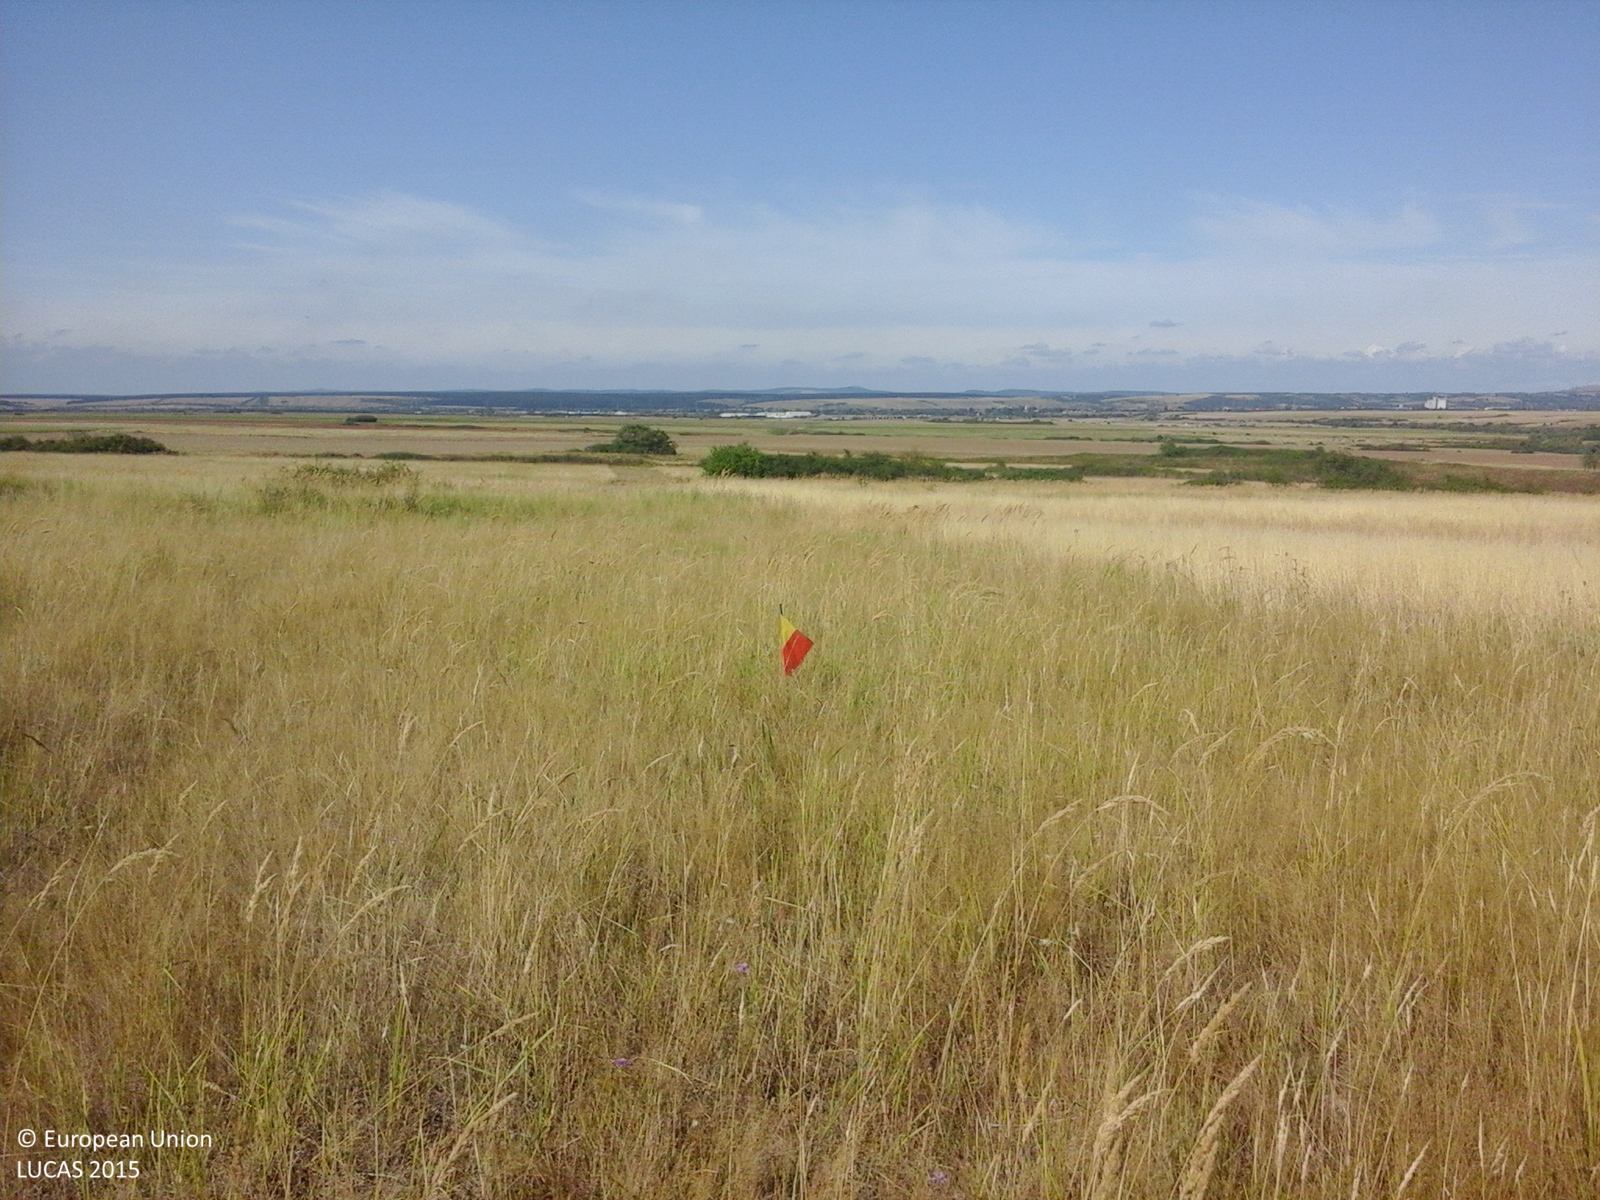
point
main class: Grassland
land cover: Grassland without tree/shrub cover
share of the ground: > 75 %
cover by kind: herbaceous plants 100 %
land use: Agriculture (excluding fallow land and kitchen gardens)
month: August
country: RO
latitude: 45.3912
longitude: 21.5923
